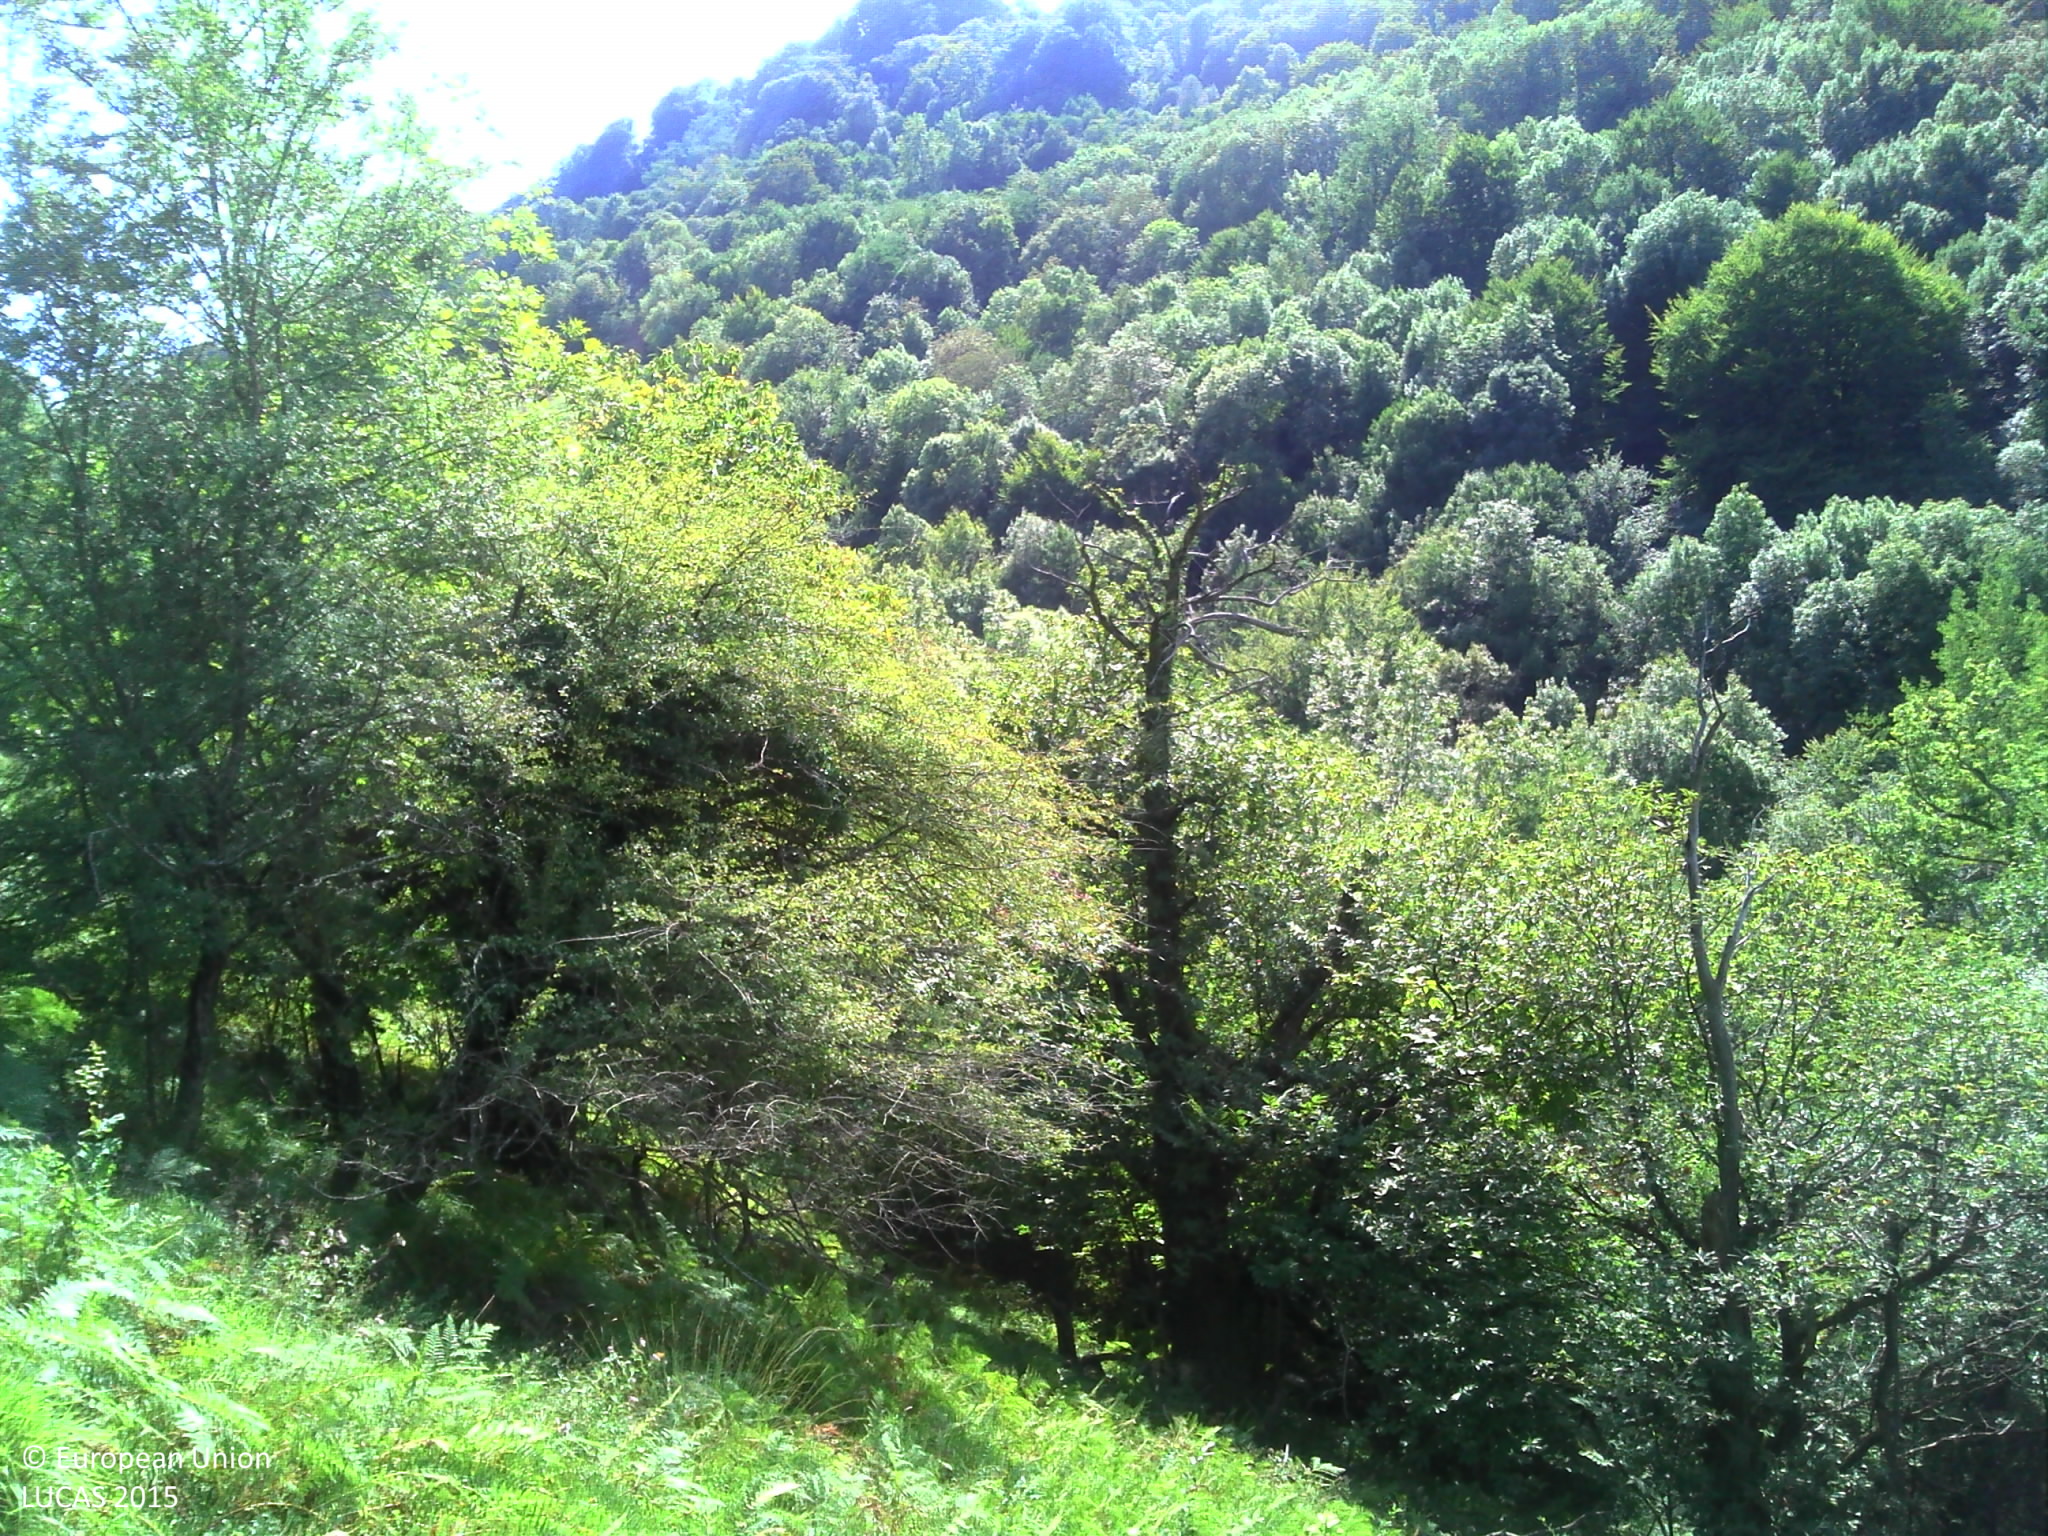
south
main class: Grassland
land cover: Spontaneously vegetated surfaces
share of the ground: > 75 %
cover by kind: herbaceous plants 90 %, shrubs 5 %, consolidated bare surface 5 %
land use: Agriculture (excluding fallow land and kitchen gardens)
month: September
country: FR
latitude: 43.1489
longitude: -0.9669
